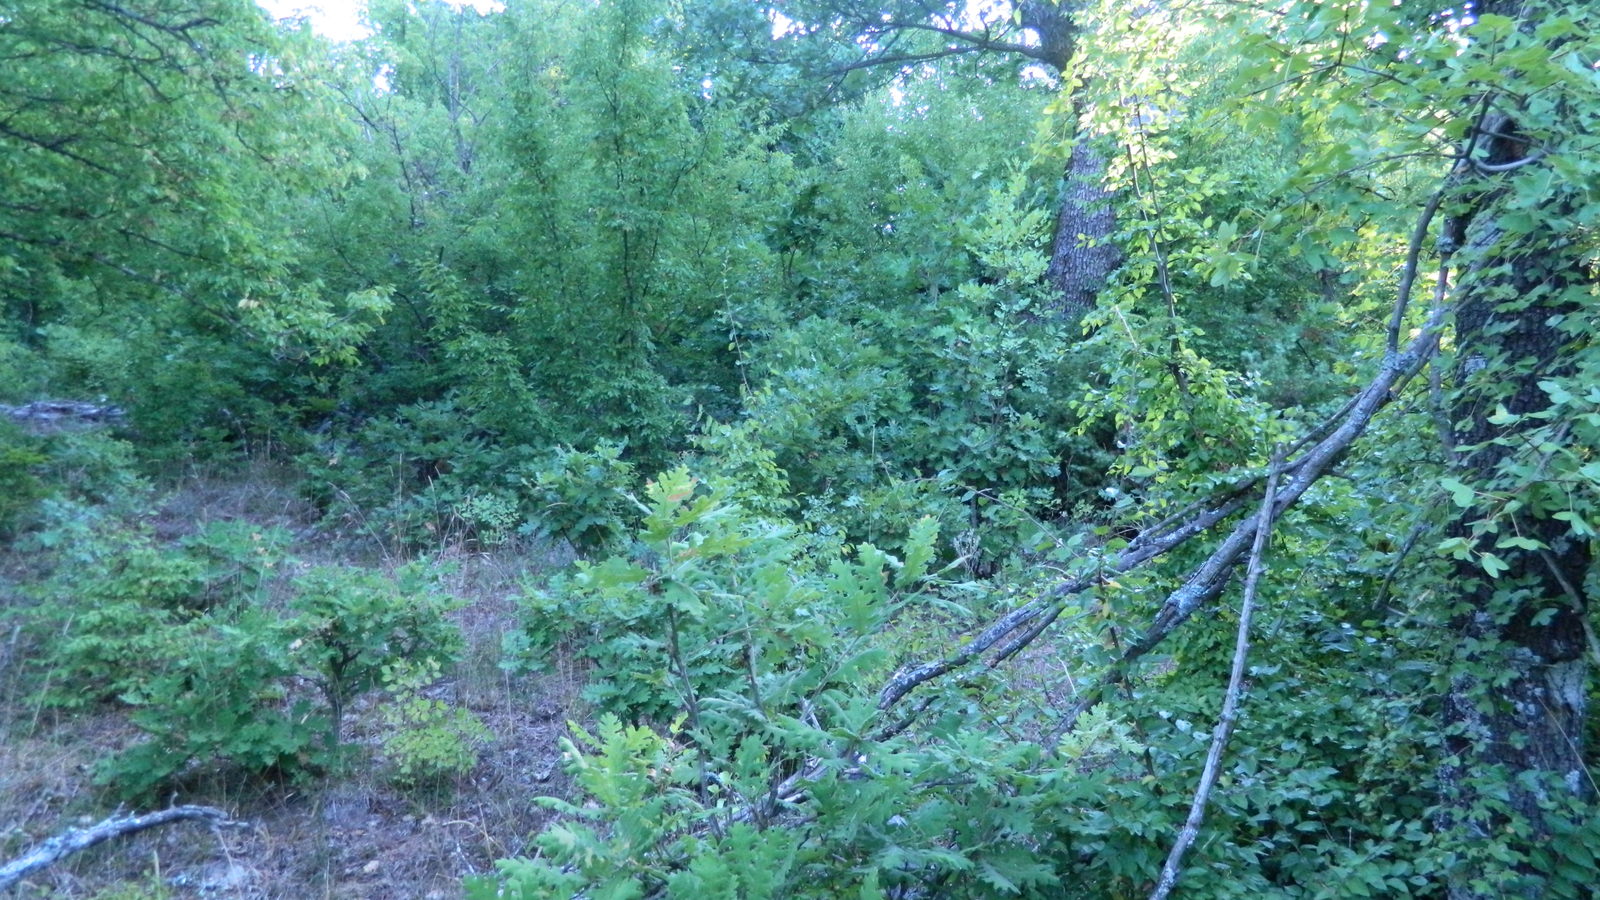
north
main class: Woodland
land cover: Broadleaved woodland
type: mesophytic deciduous forest
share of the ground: > 75 %
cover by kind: broadleaved forest trees 70 %, shrubs 15 %, unconsolidated bare surface 10 %, herbaceous plants 5 %
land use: Forestry
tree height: > 5 m
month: August
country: BG
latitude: 41.6490
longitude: 25.8805
